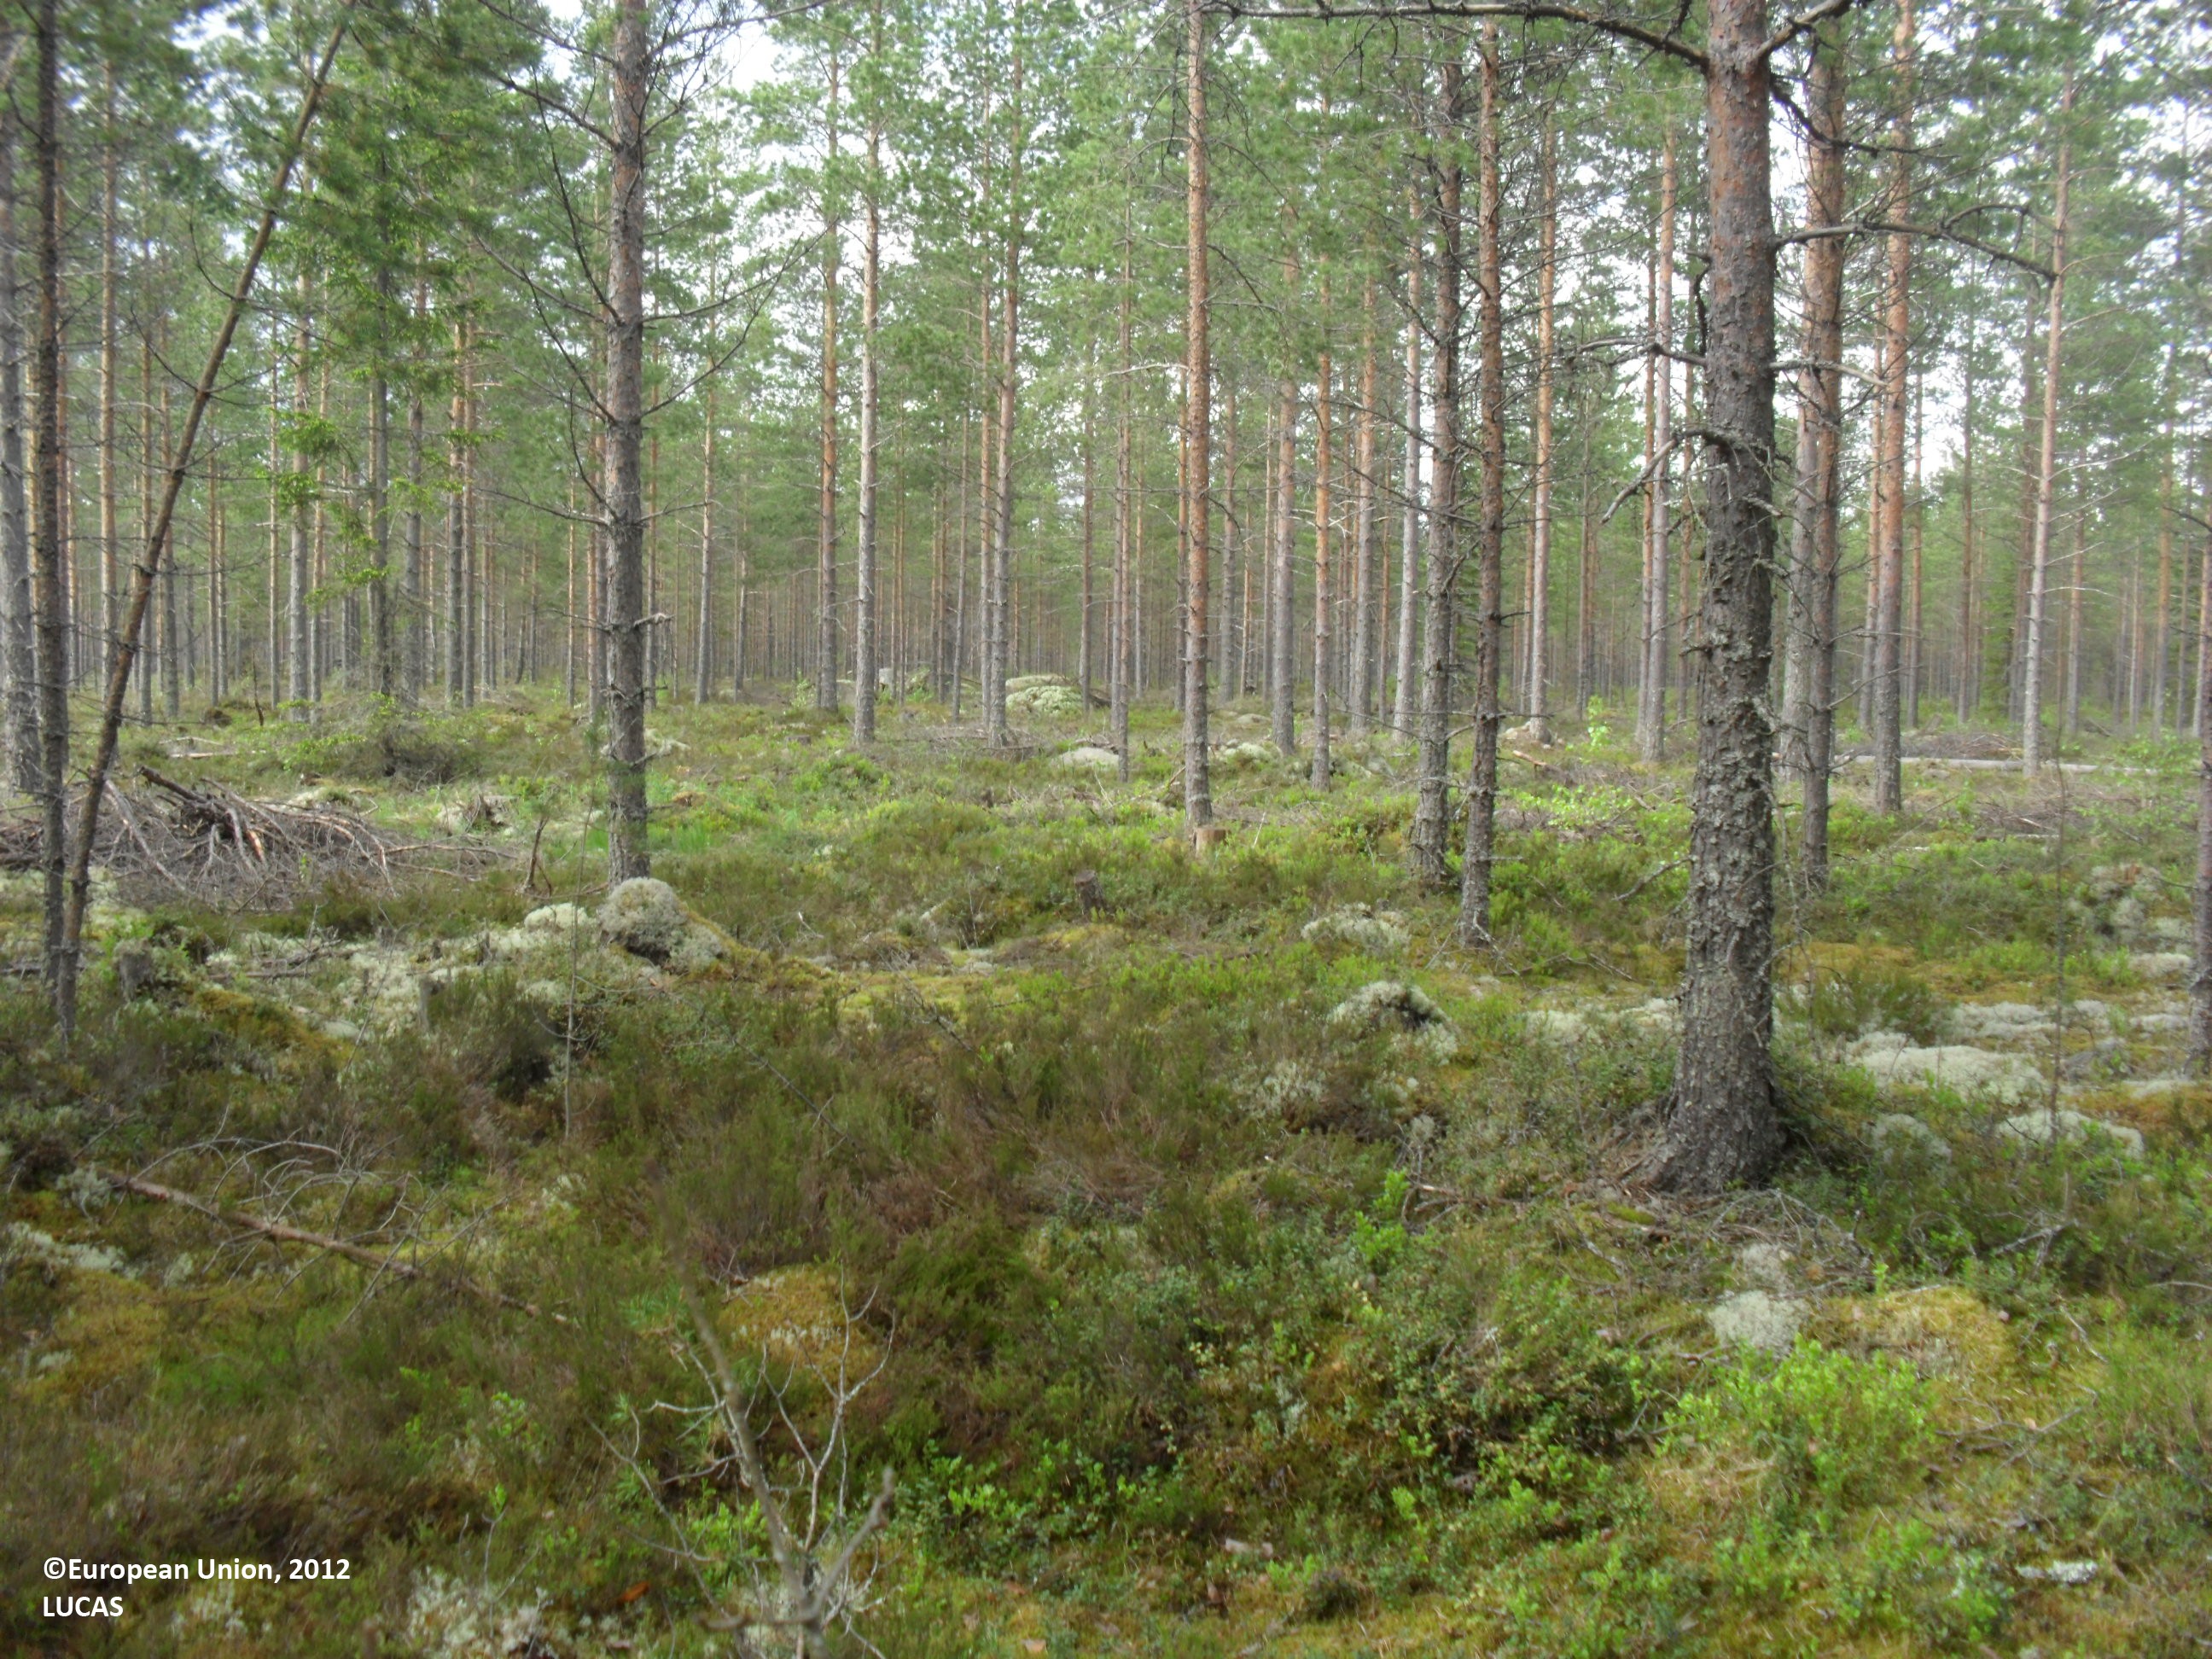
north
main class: Woodland
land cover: Pine dominated coniferous woodland
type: boreal forest
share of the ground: 50 - 75 %
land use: Forestry
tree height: > 5 m
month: June
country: FI
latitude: 62.7894
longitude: 23.2970
